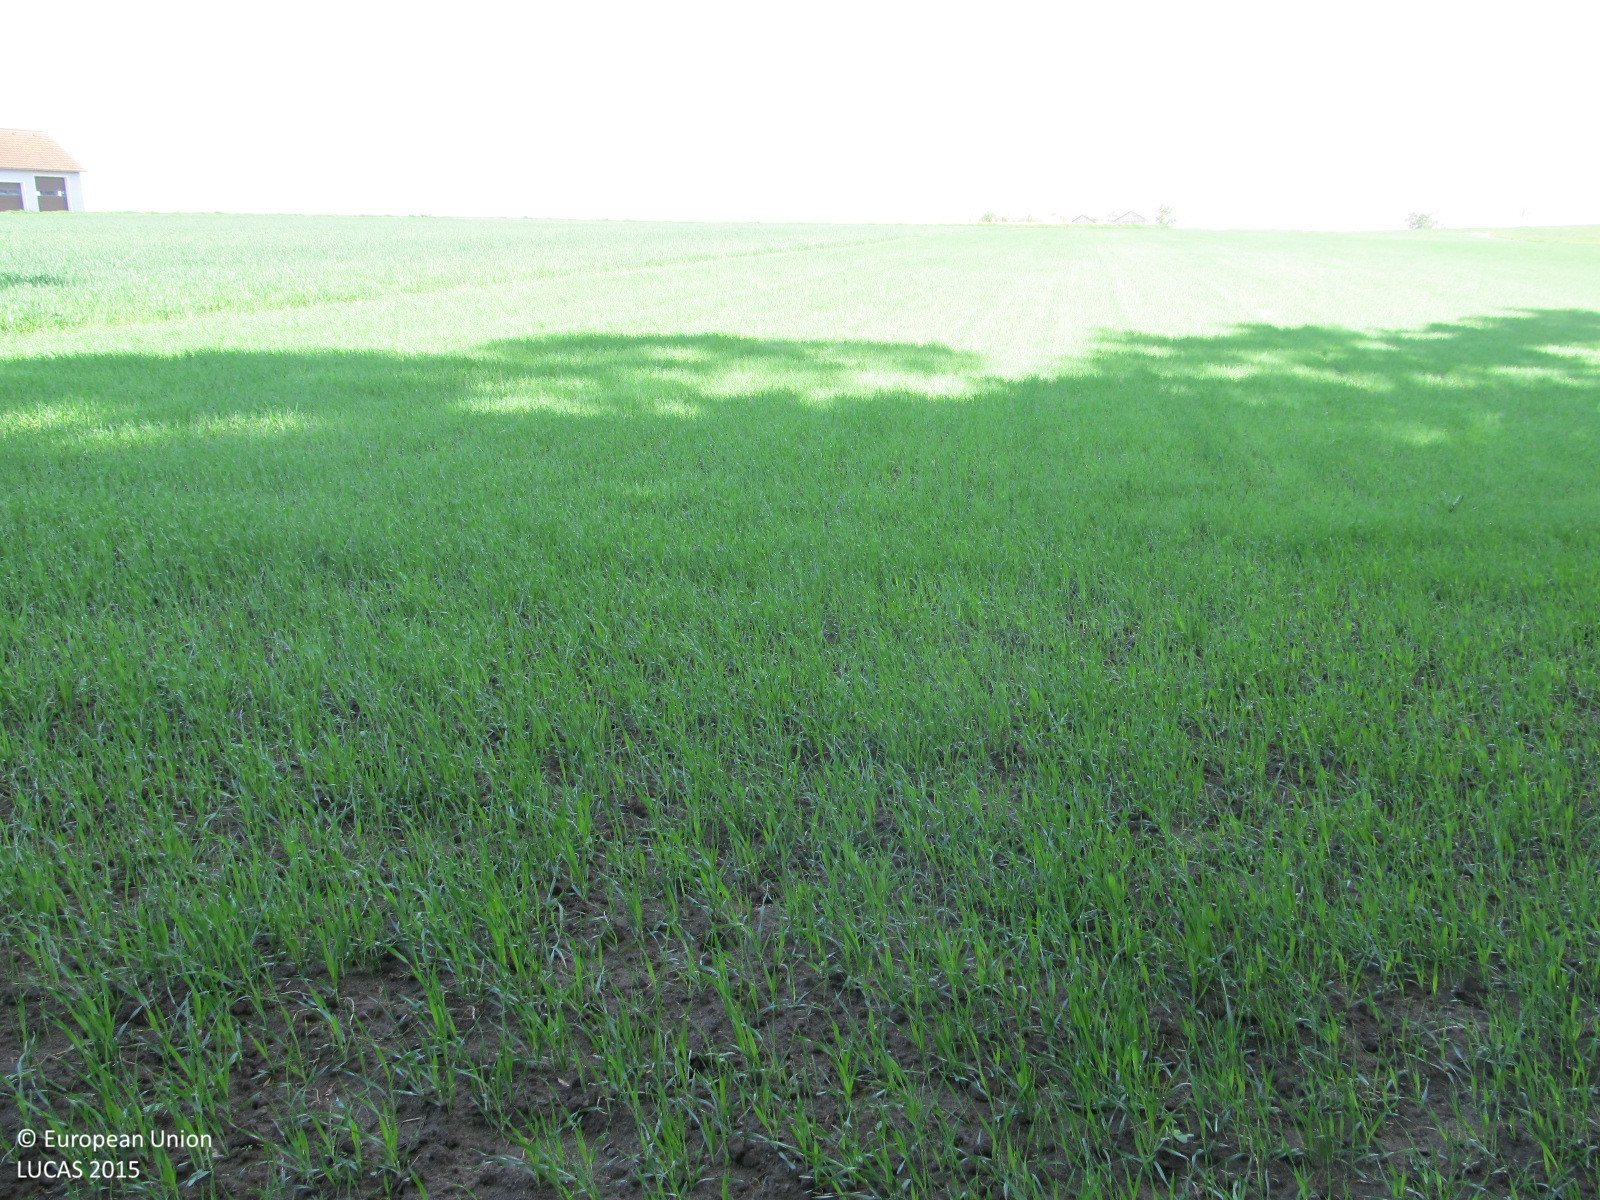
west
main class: Cropland
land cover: Common wheat
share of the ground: > 75 %
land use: Agriculture (excluding fallow land and kitchen gardens)
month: May
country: AT
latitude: 48.5736
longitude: 15.4919
